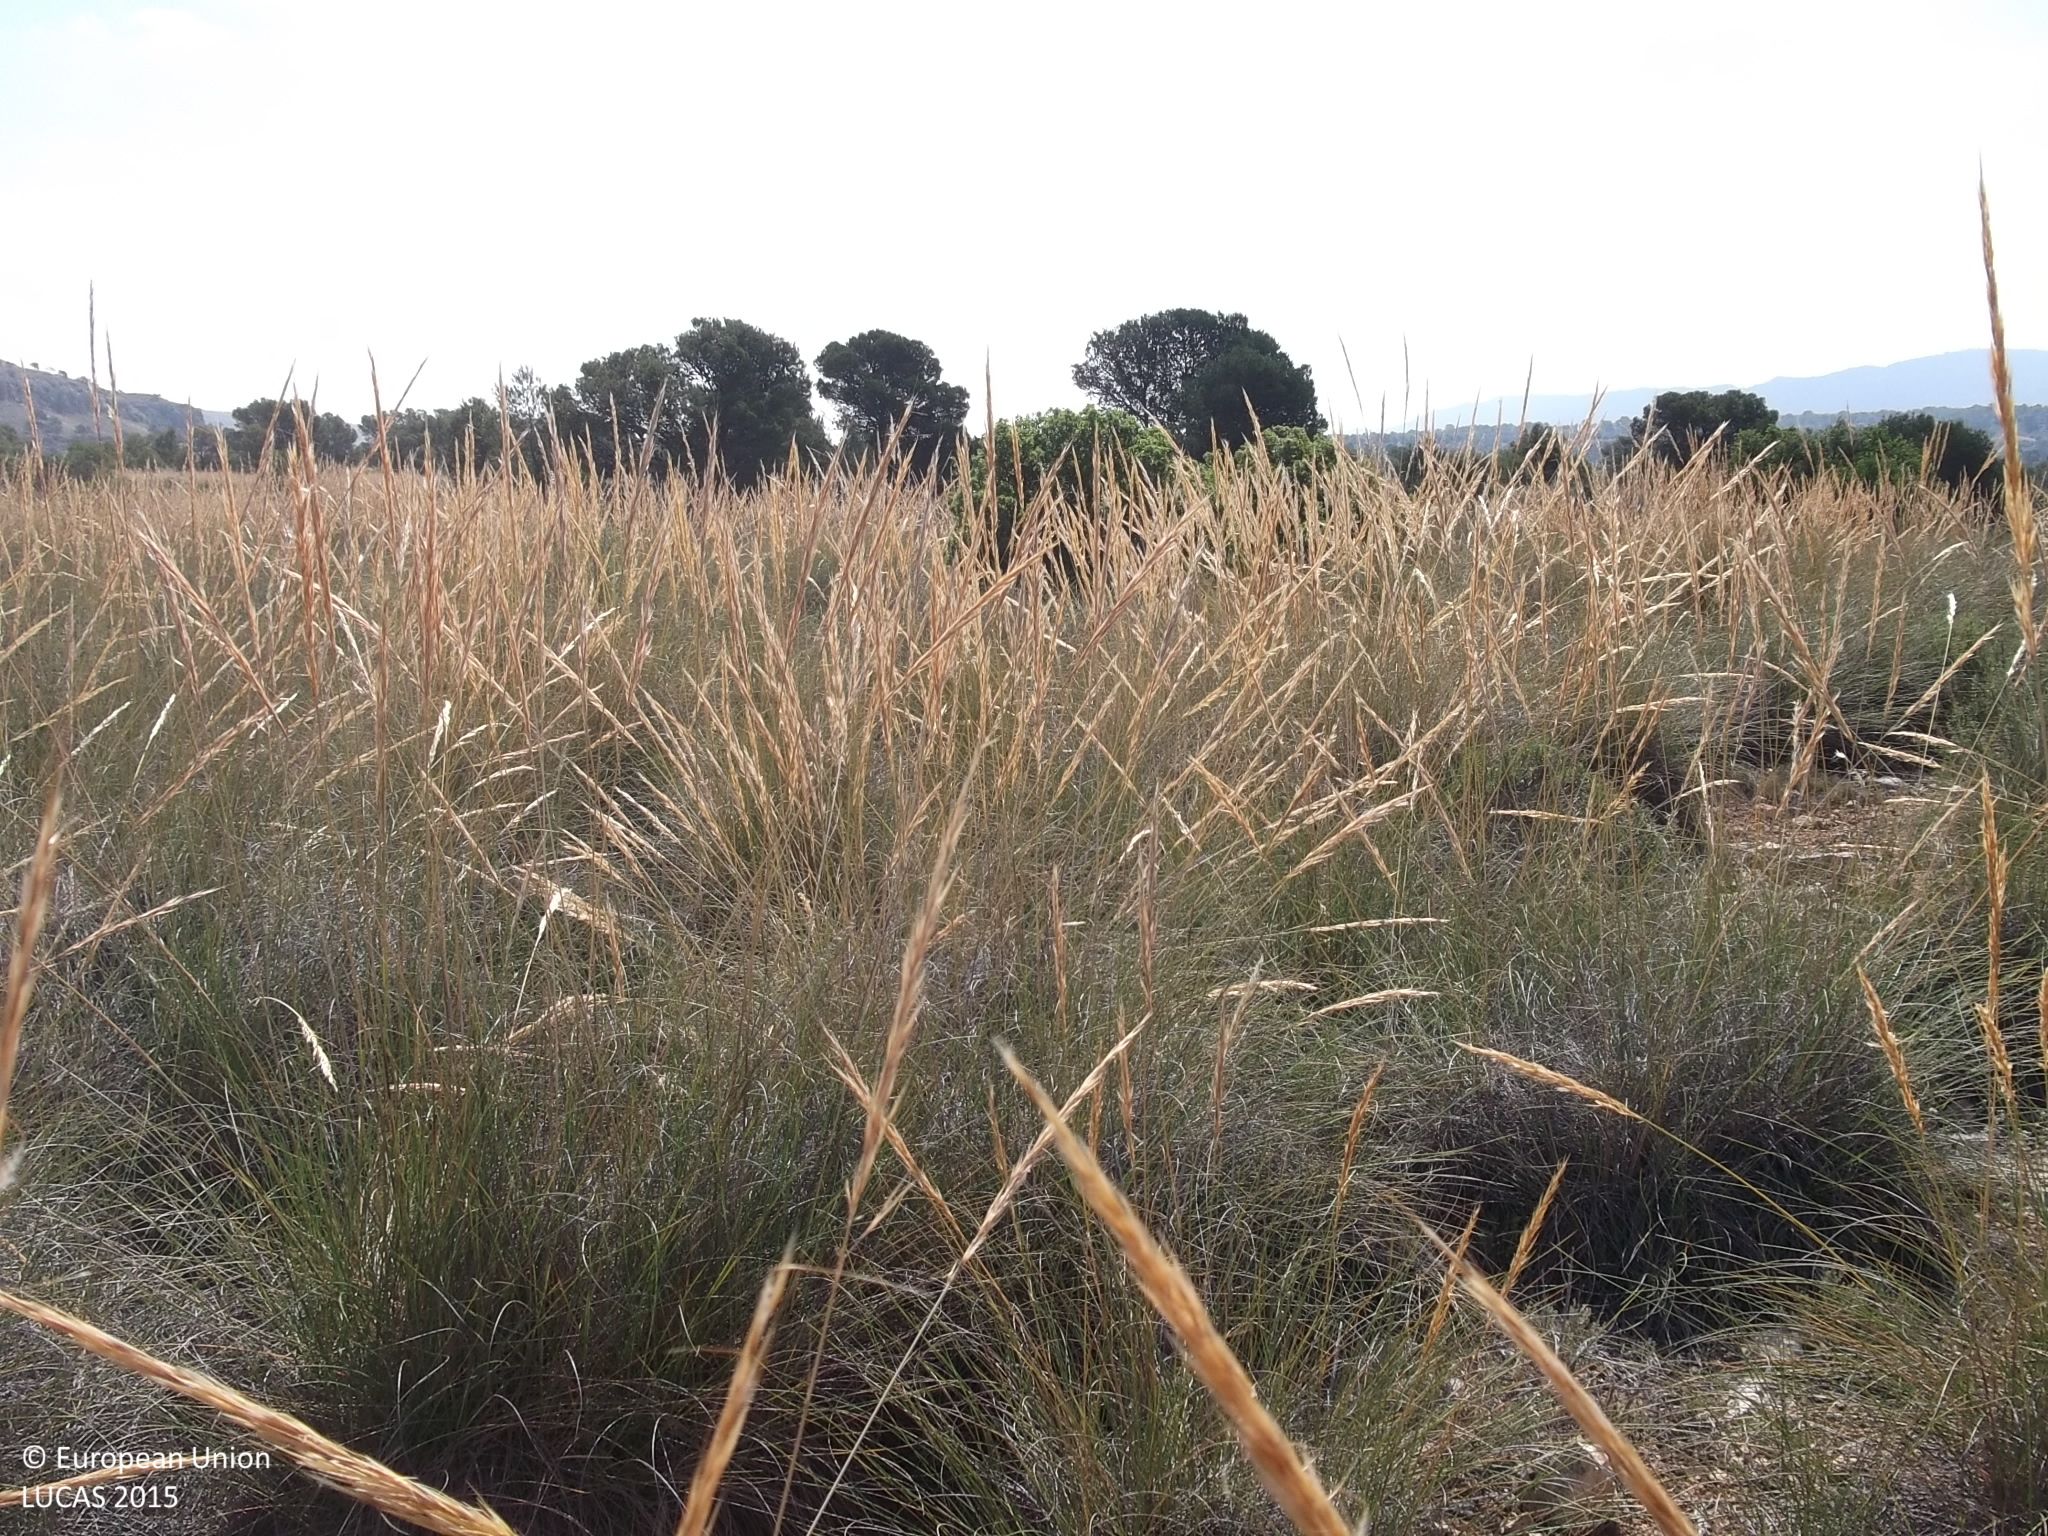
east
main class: Shrubland
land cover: Shrubland without tree cover
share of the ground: 50 - 75 %
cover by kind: shrubs 50 %, herbaceous plants 30 %, consolidated bare surface 20 %
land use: Semi-natural and natural areas not in use
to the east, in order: Shrubland without tree cover; Shrubland with sparse tree cover; Tracks; Shrubland without tree cover
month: May
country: ES
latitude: 38.4756
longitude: -1.4885
